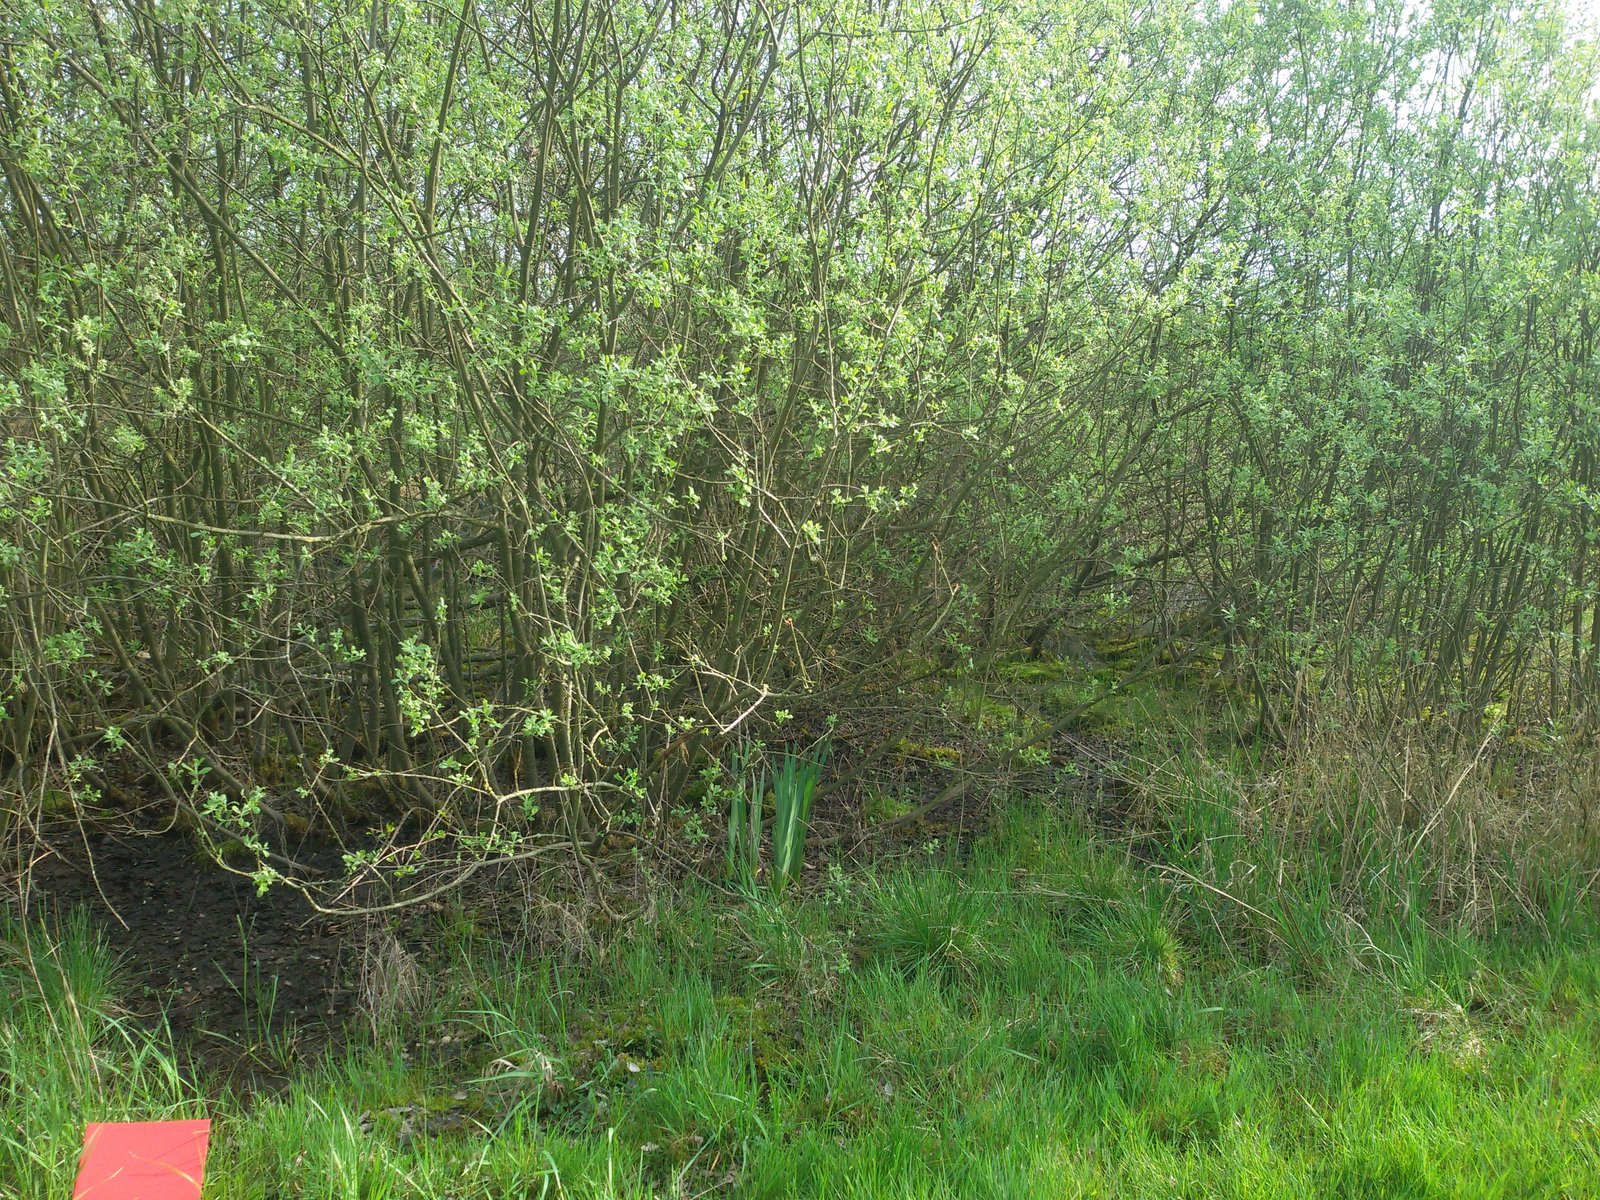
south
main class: Grassland
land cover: Grassland without tree/shrub cover
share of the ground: > 75 %
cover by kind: herbaceous plants 100 %
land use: Agriculture (excluding fallow land and kitchen gardens)
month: May
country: PL
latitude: 53.4533
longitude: 17.2840
